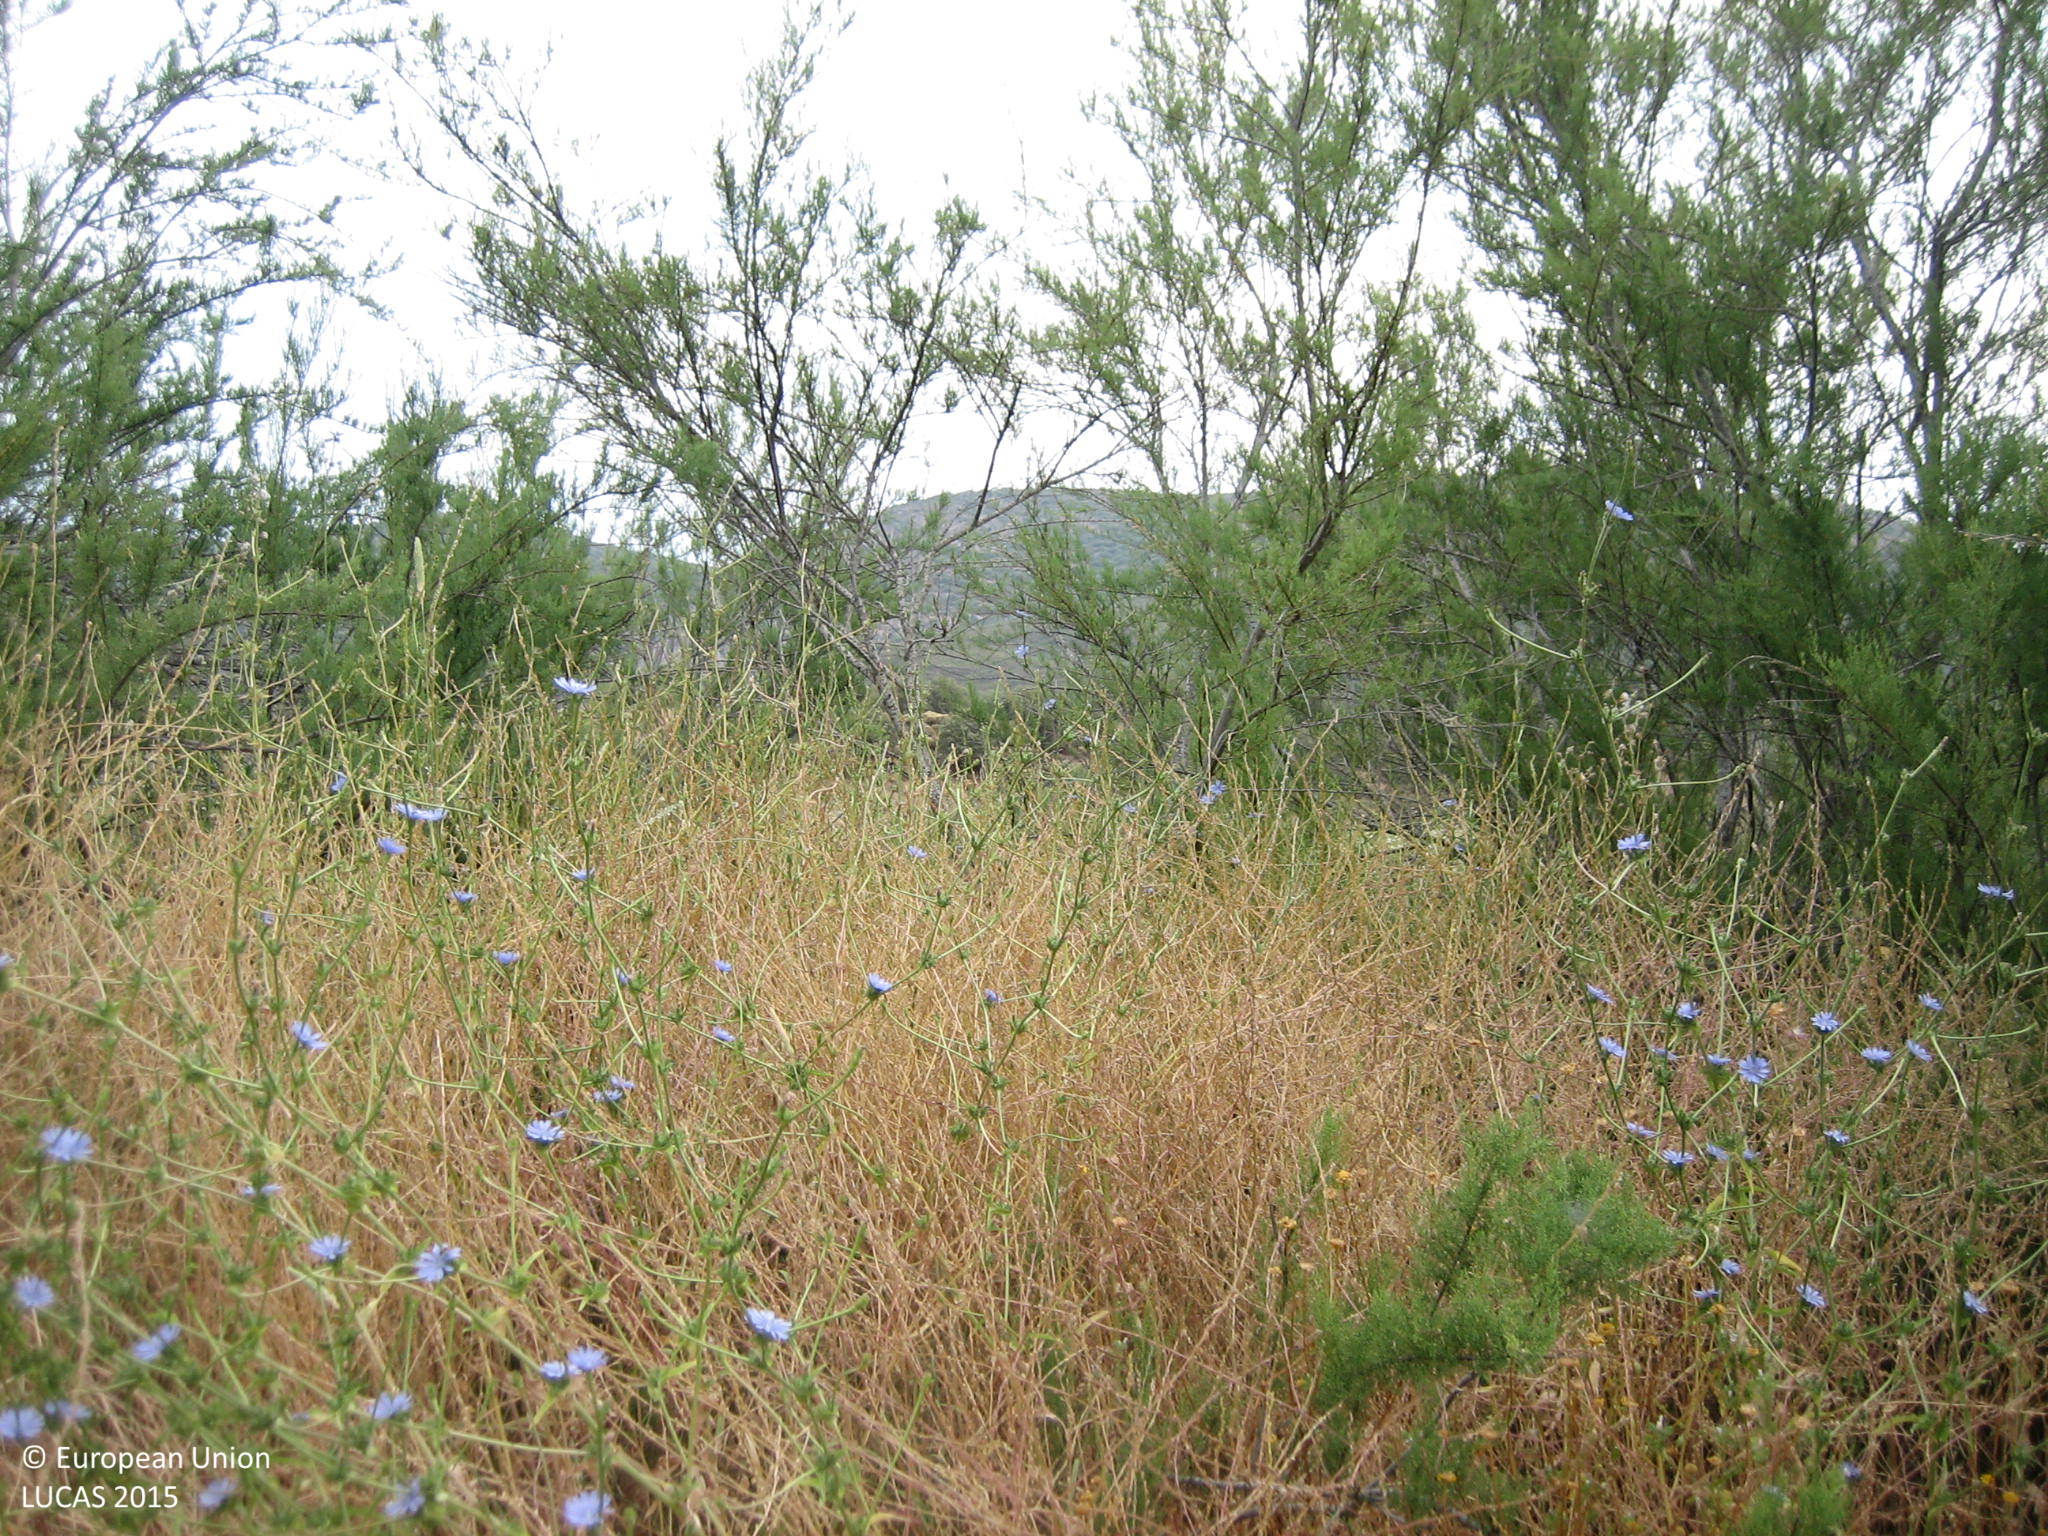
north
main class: Shrubland
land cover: Shrubland without tree cover
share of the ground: > 75 %
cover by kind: shrubs 80 %, herbaceous plants 20 %
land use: Semi-natural and natural areas not in use
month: June
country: ES
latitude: 39.0970
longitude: -4.5882
